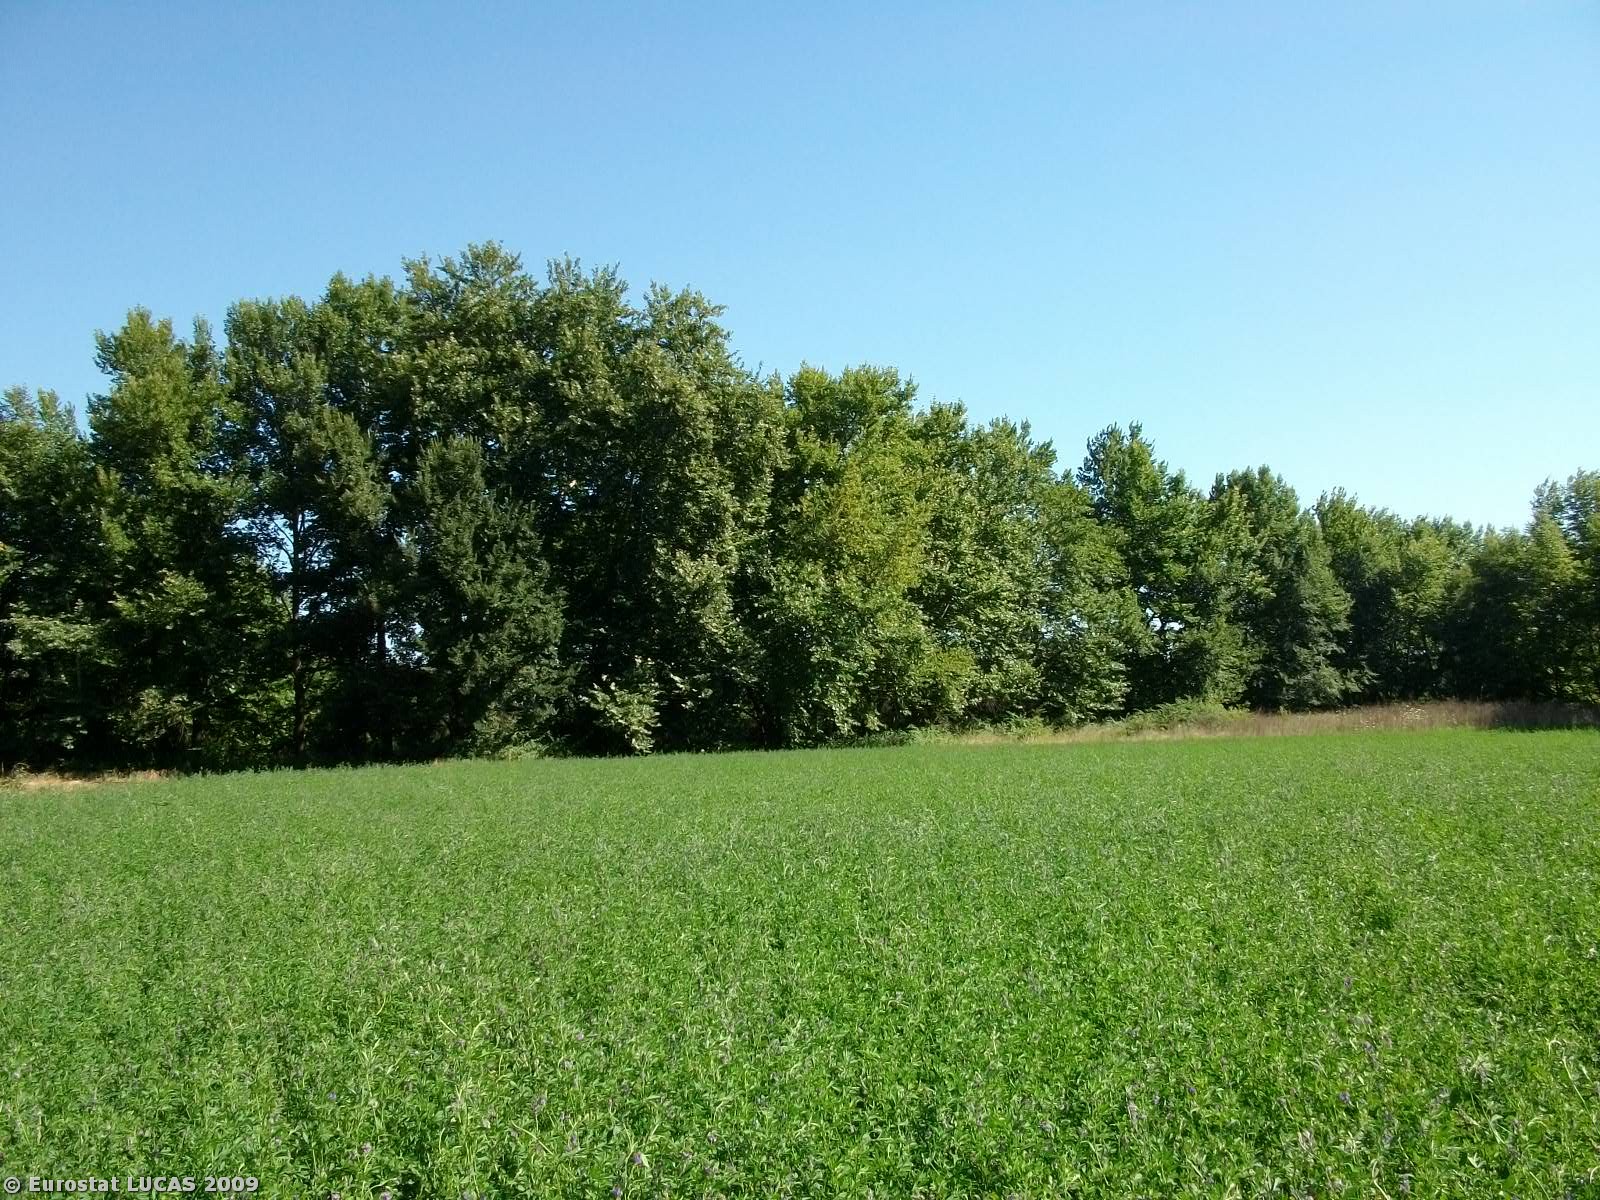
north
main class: Cropland
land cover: Clovers
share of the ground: > 75 %
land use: Agriculture (excluding fallow land and kitchen gardens)
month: July
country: GR
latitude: 39.5670
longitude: 21.6811
